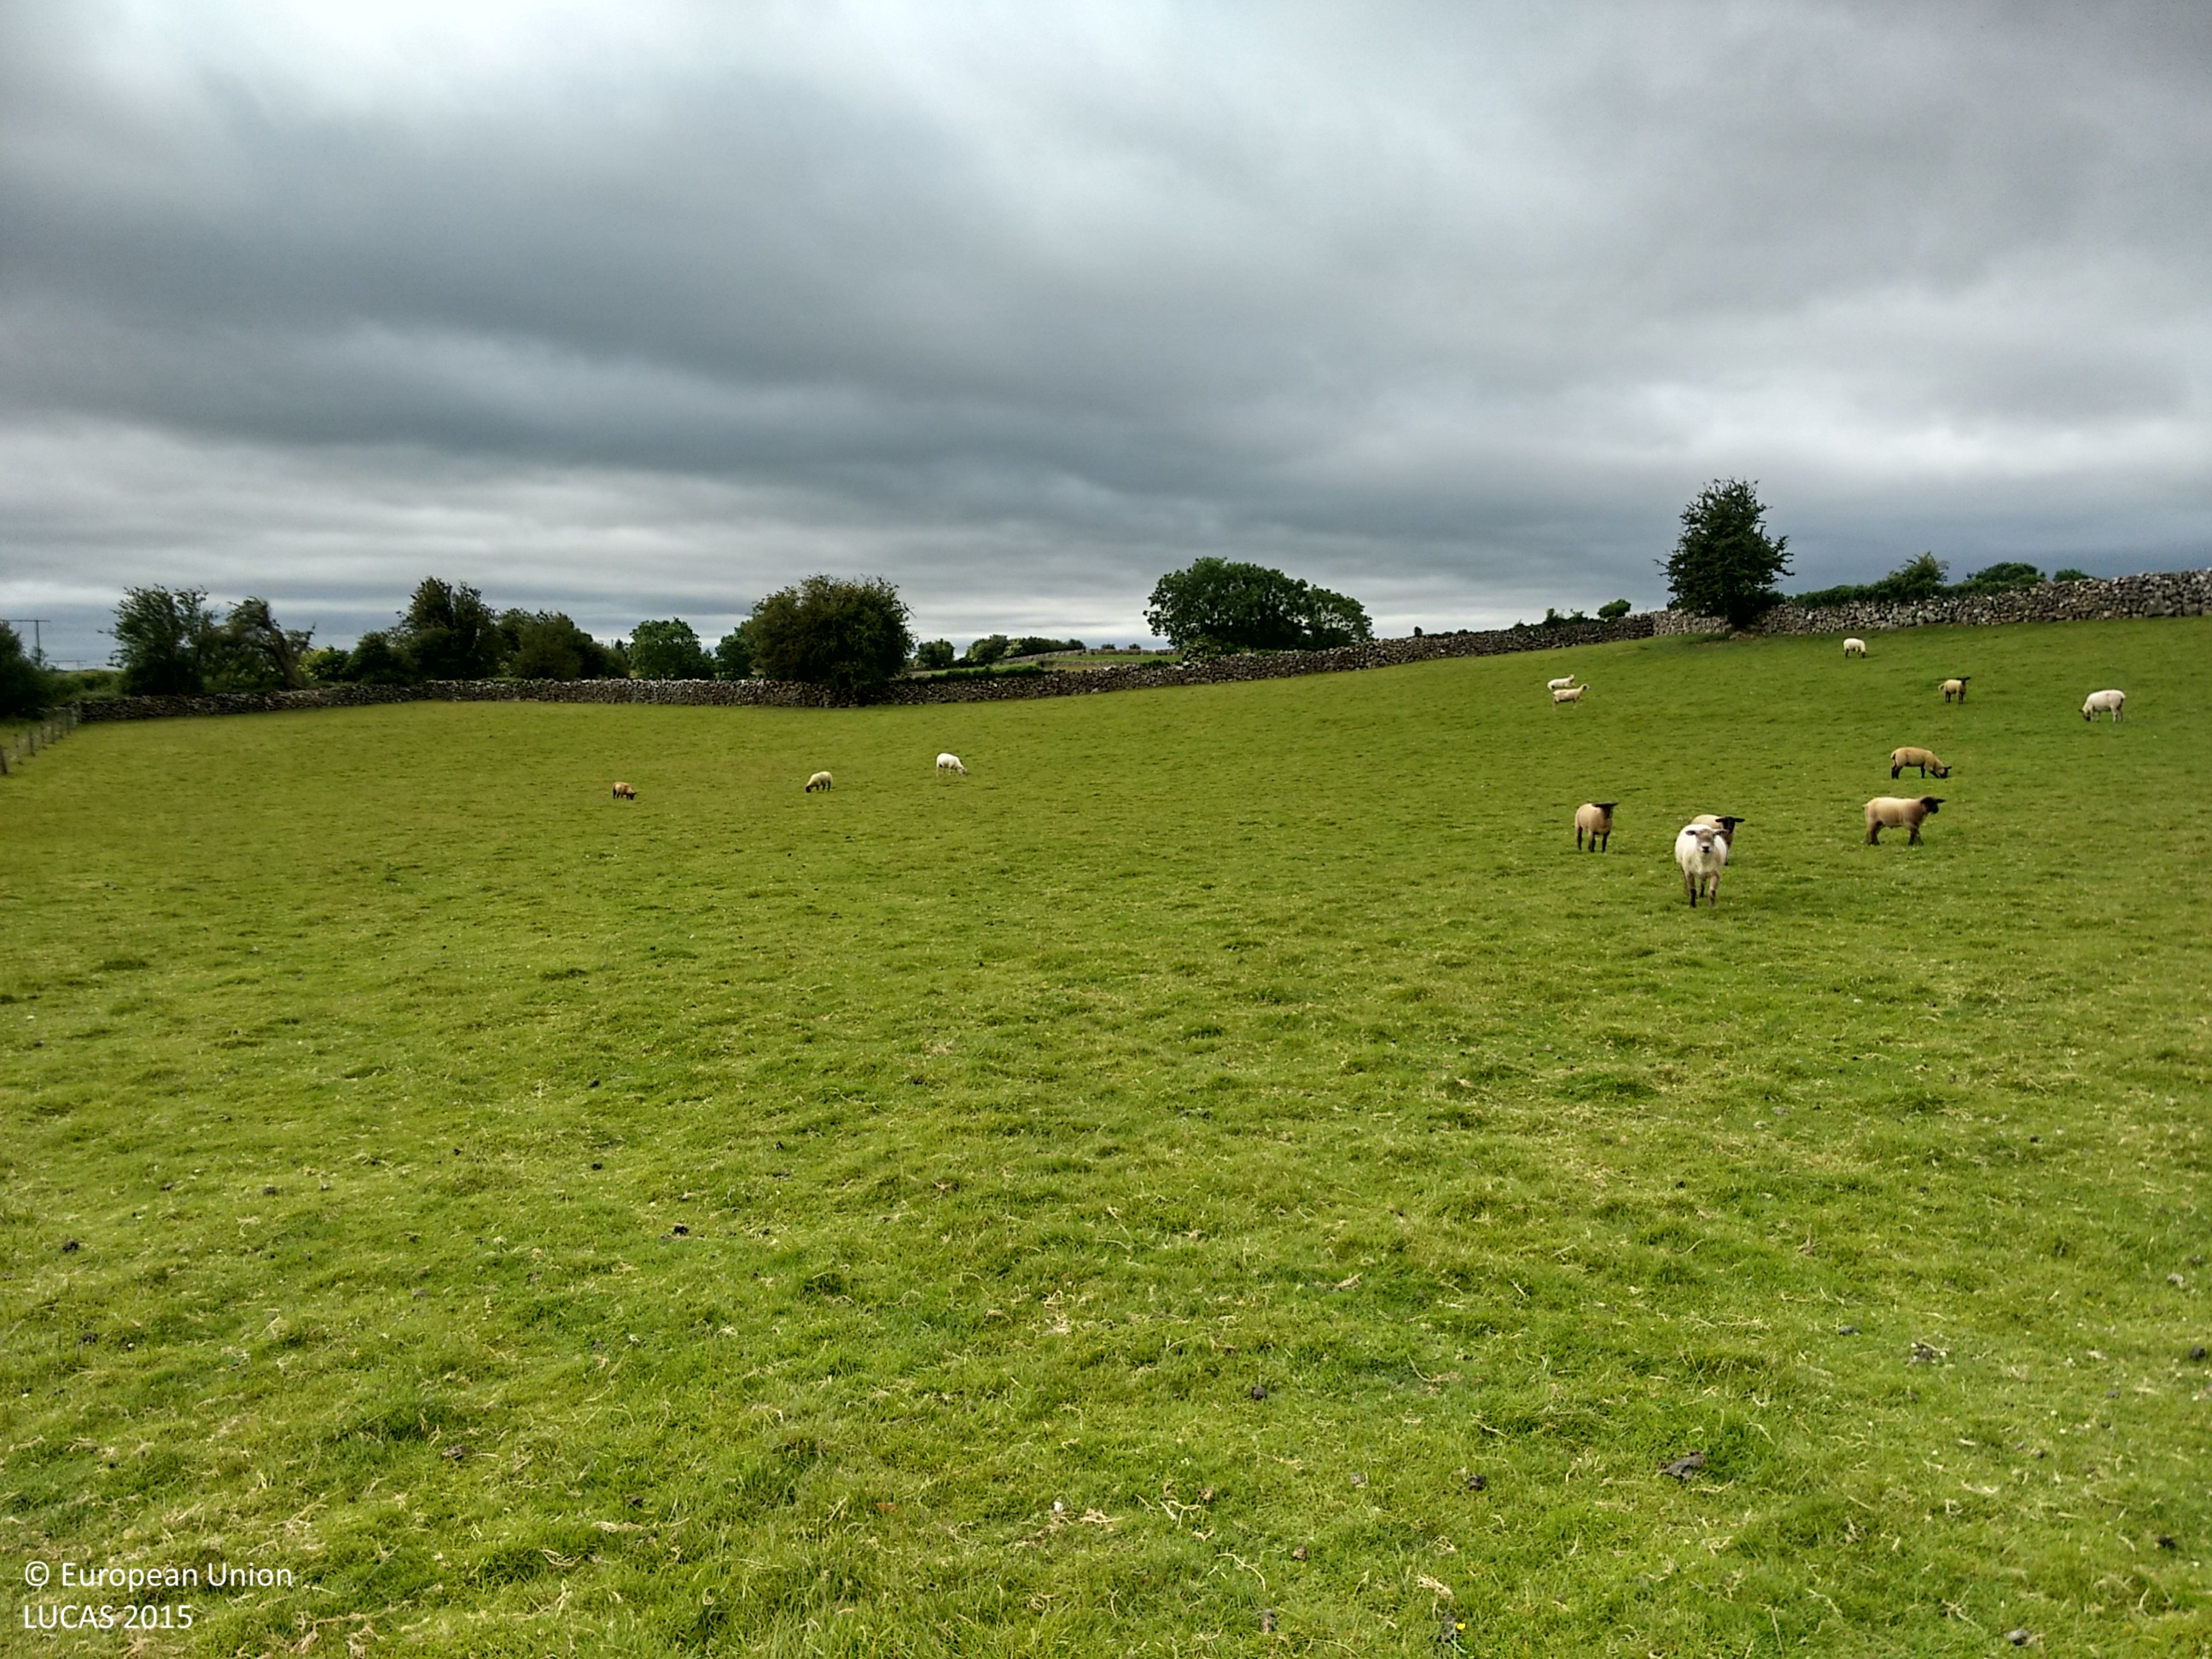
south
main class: Grassland
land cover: Grassland without tree/shrub cover
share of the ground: > 75 %
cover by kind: herbaceous plants 100 %
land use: Agriculture (excluding fallow land and kitchen gardens)
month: June
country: IE
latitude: 53.4715
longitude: -8.0286
